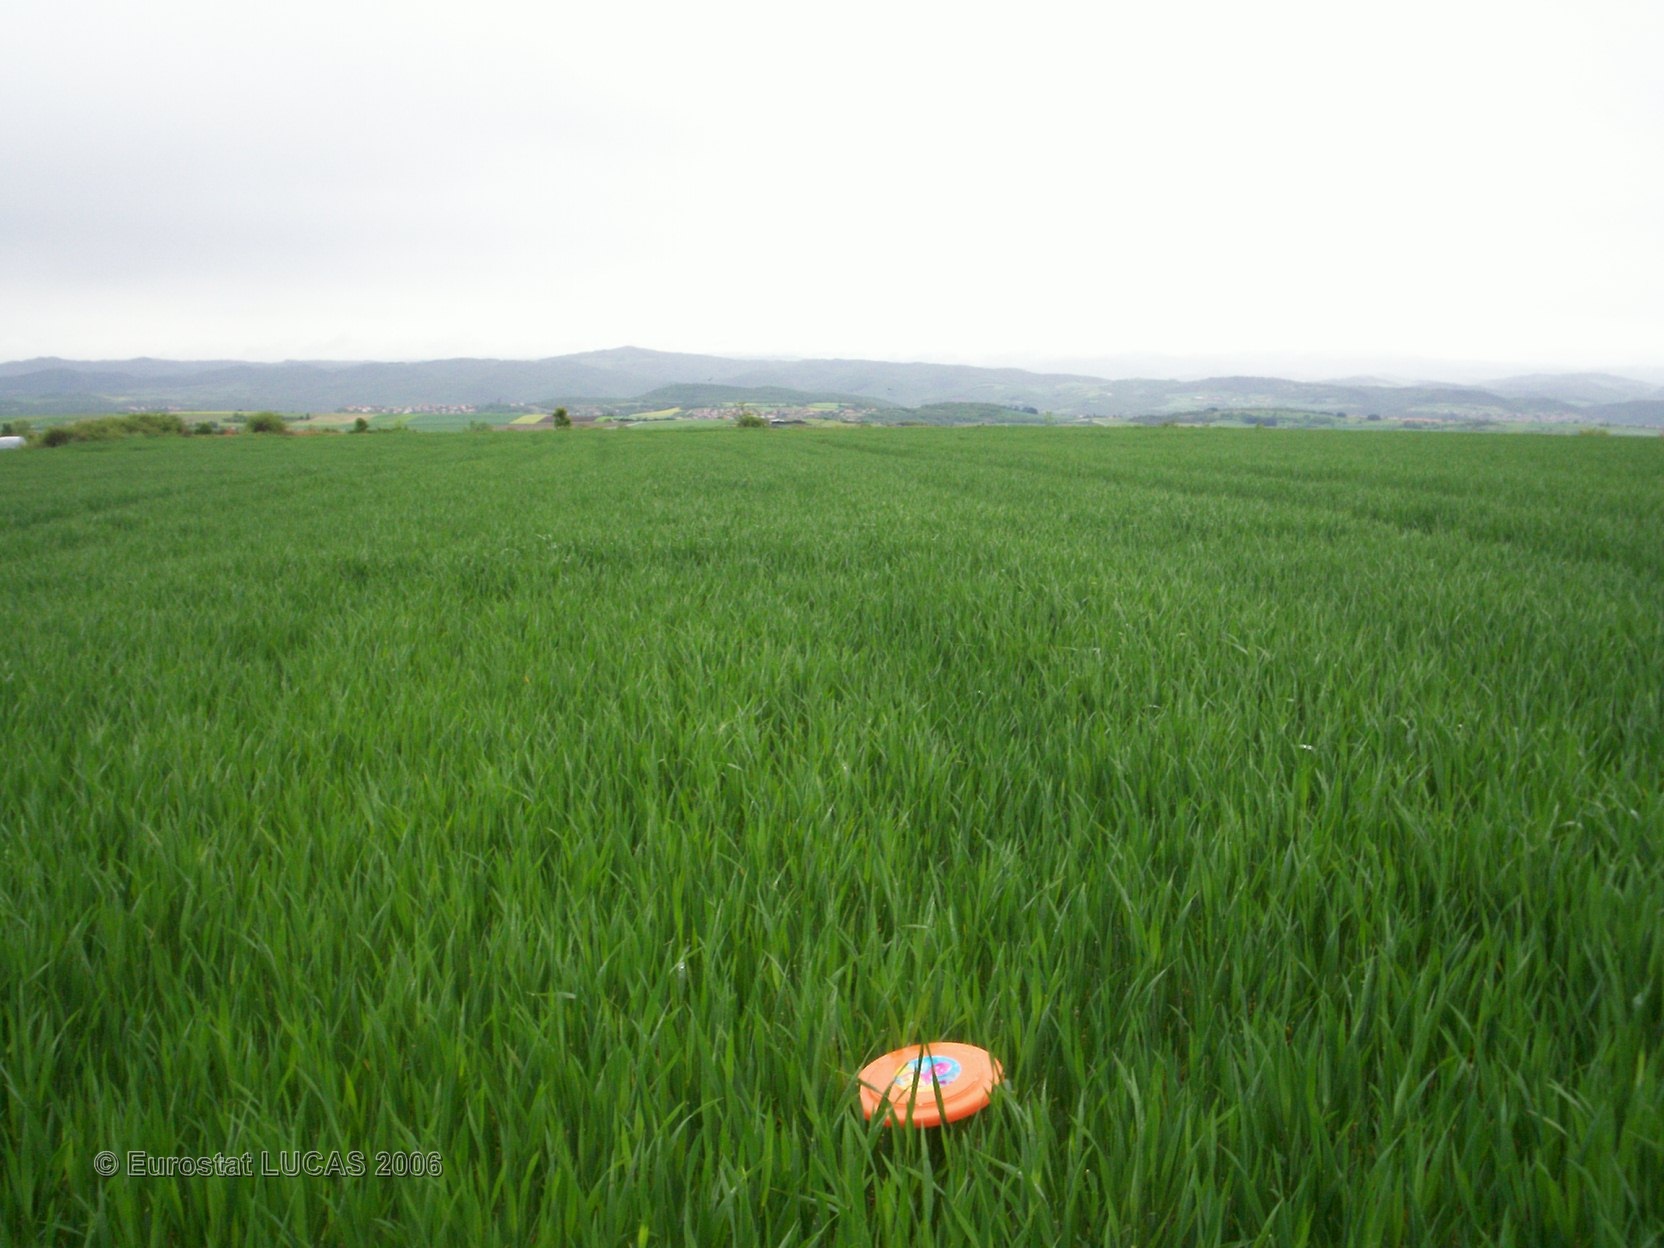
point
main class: Cropland
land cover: Common wheat
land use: Agriculture (excluding fallow land and kitchen gardens)
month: May
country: FR
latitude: 45.4143
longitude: 3.2417
